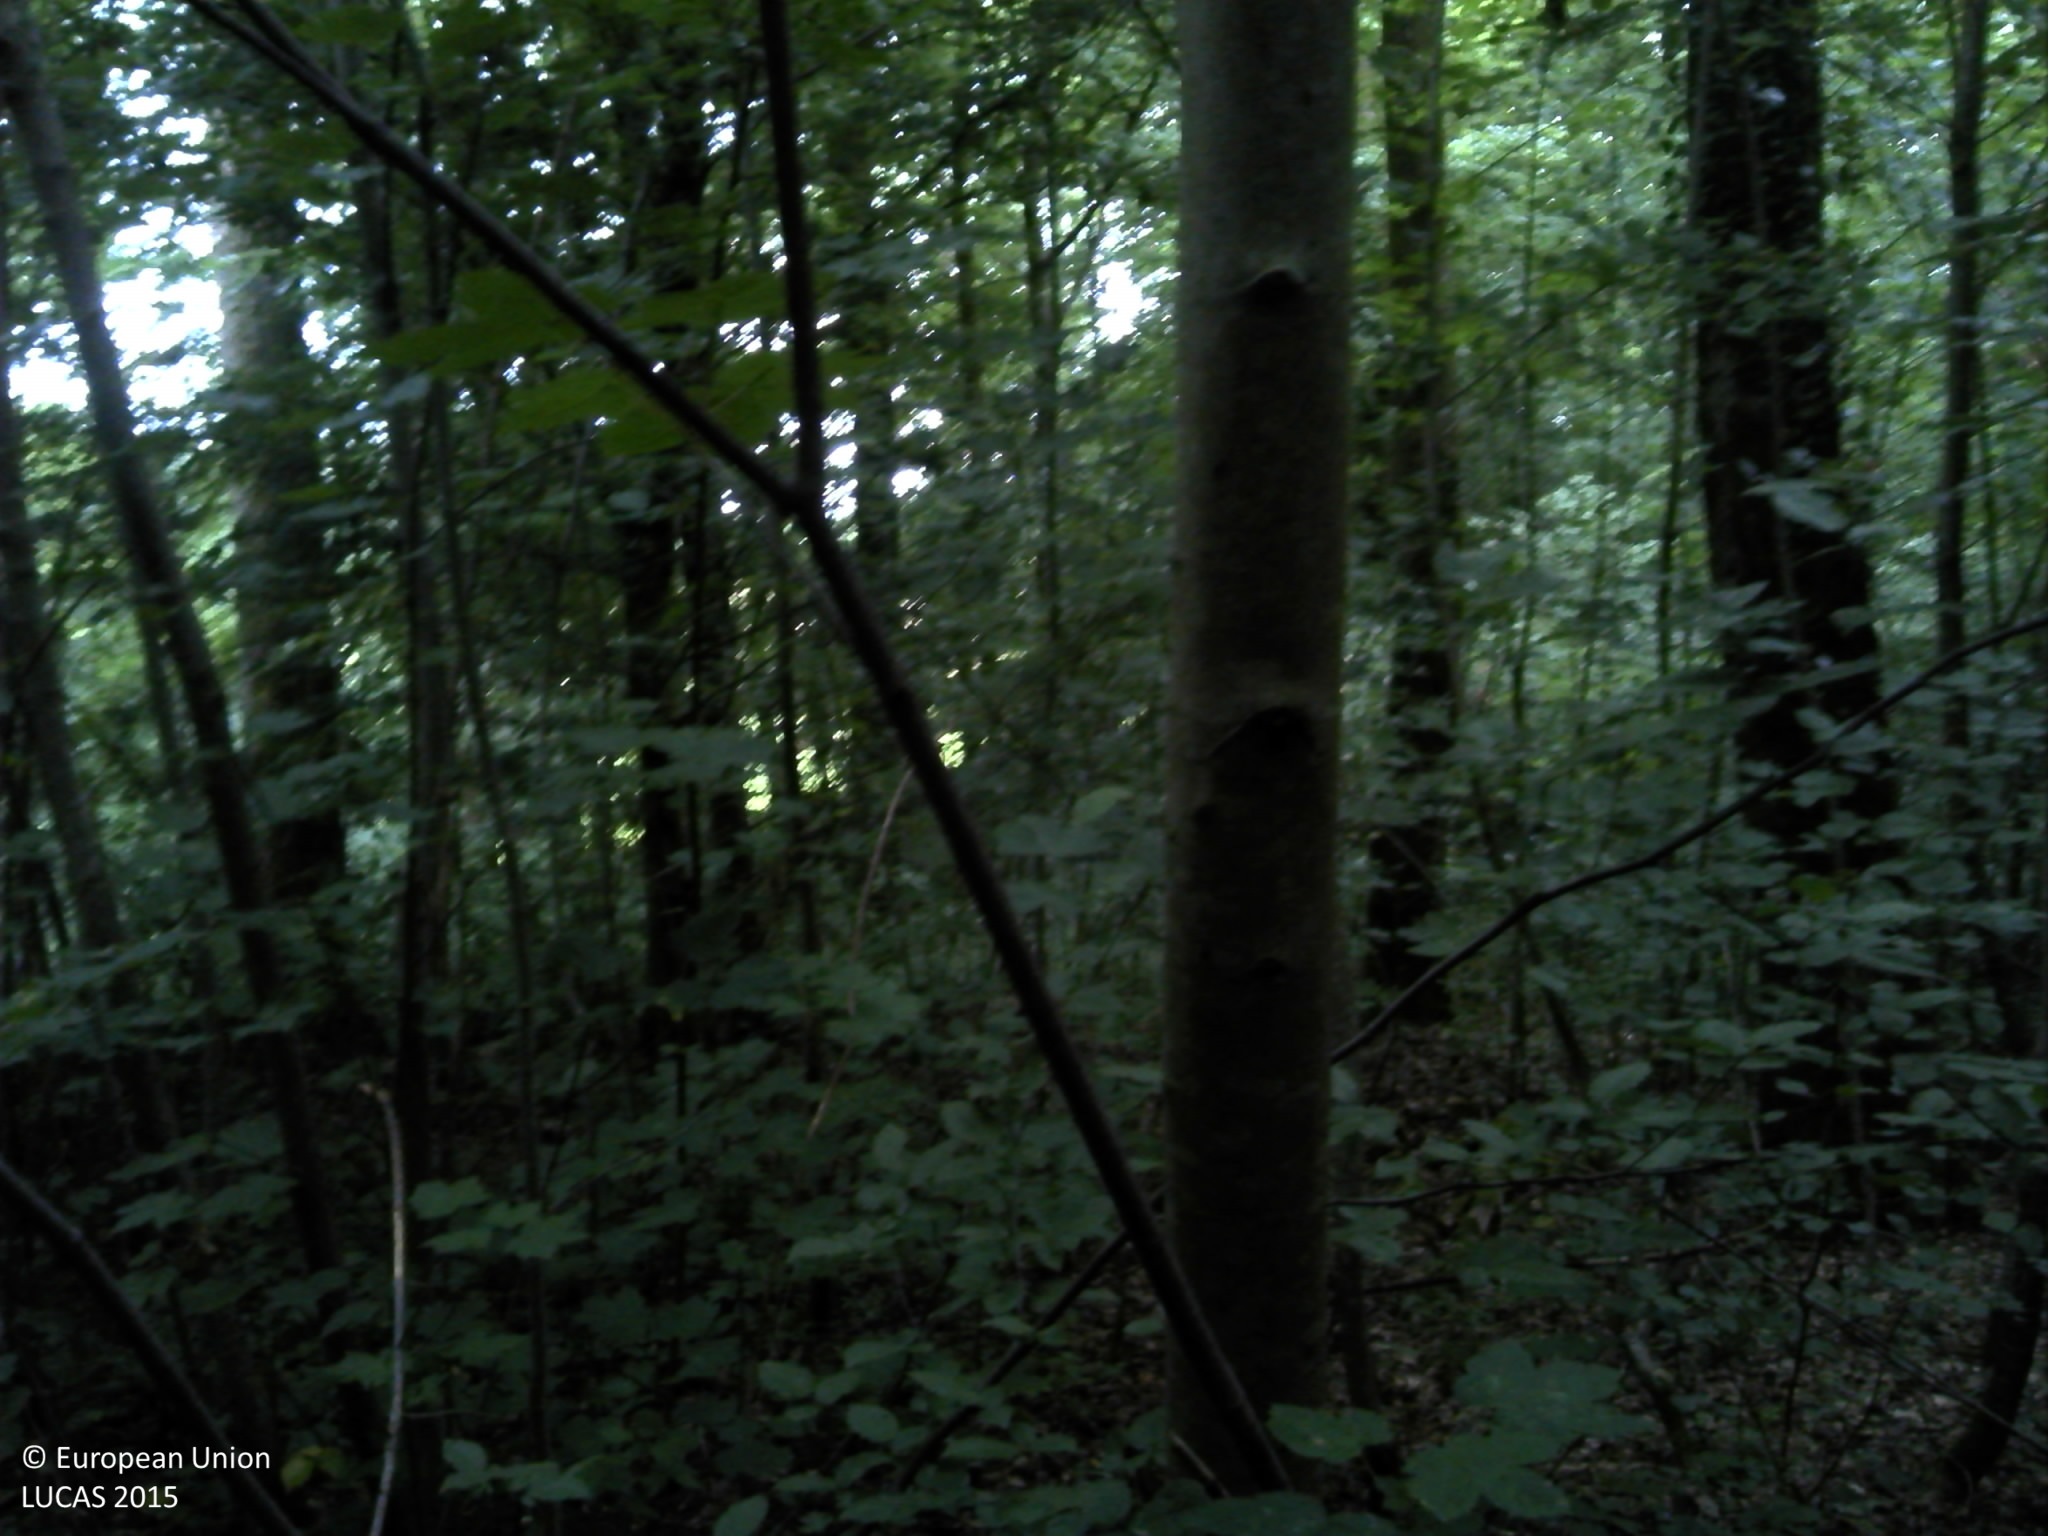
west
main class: Woodland
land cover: Broadleaved woodland
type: beech forest
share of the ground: > 75 %
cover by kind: broadleaved forest trees 80 %, consolidated bare surface 15 %, herbaceous plants 5 %
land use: Forestry
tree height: > 5 m
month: July
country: FR
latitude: 49.6728
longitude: 4.4949
